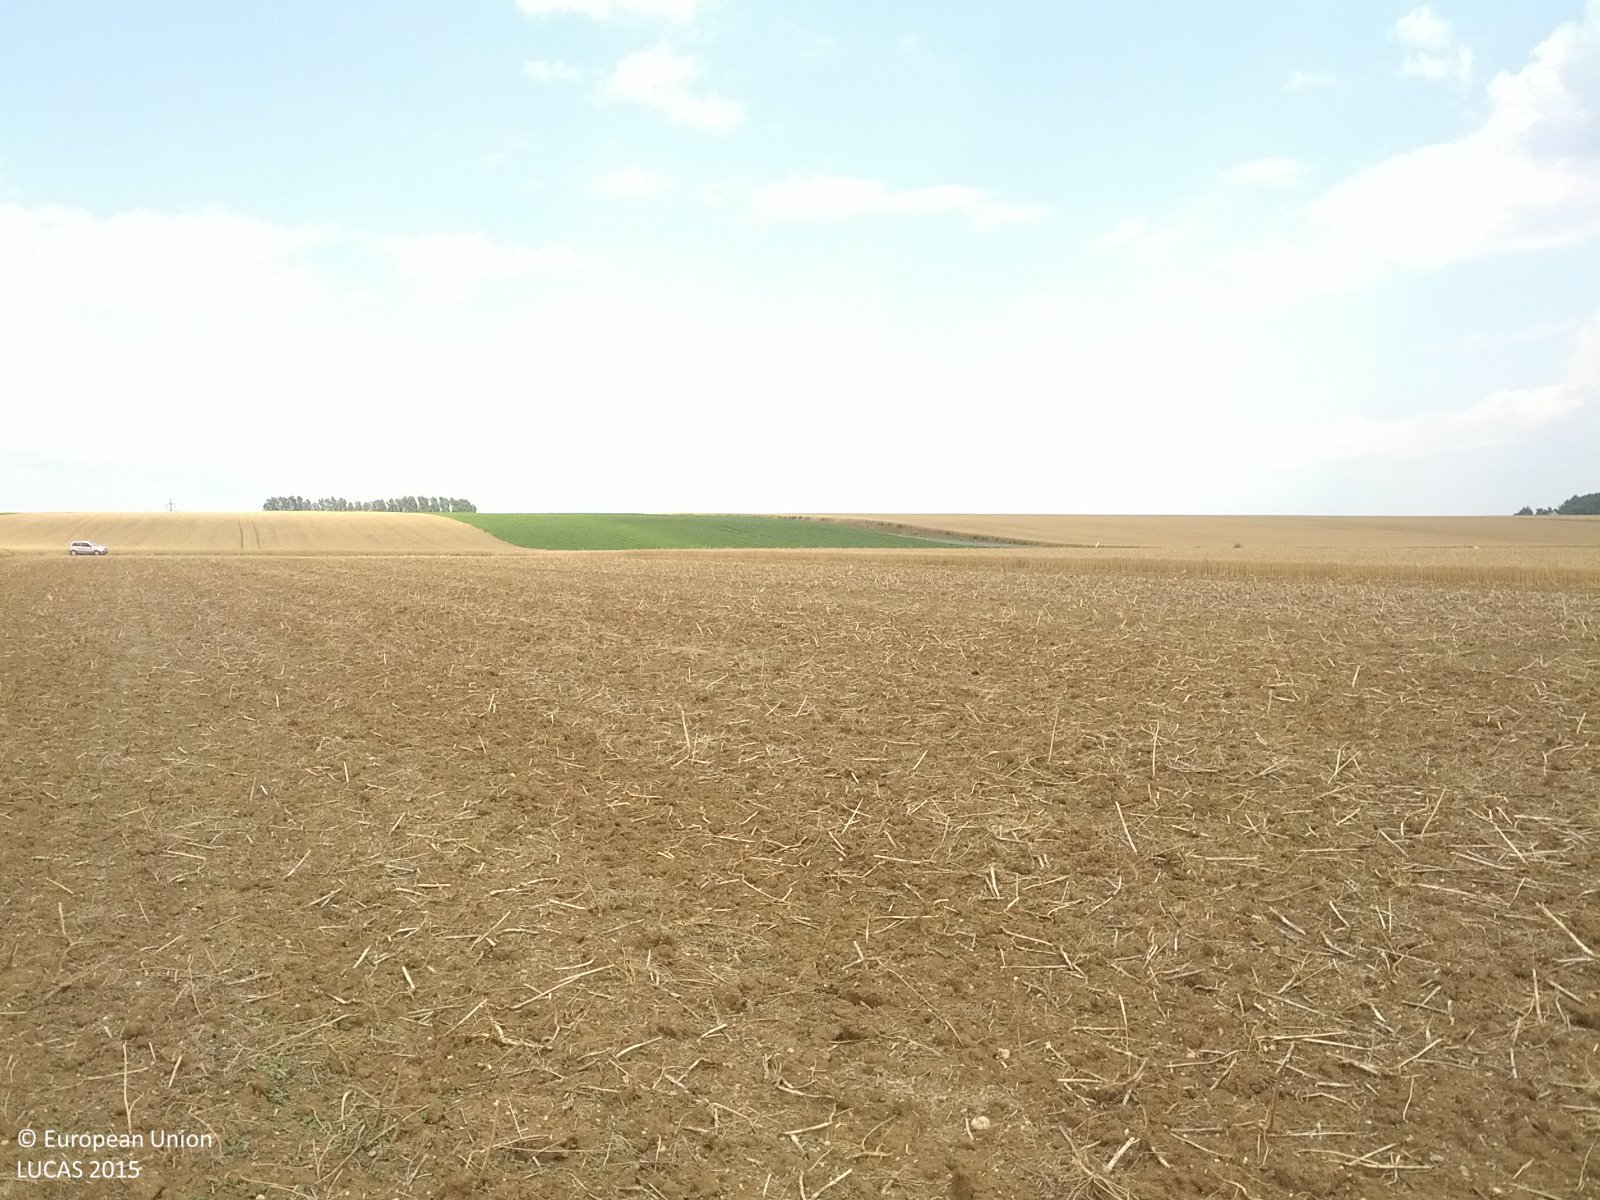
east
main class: Cropland
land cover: Rape and turnip rape
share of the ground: < 10 %
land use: Agriculture (excluding fallow land and kitchen gardens)
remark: Harvested field
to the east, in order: Rape and turnip rape; Common wheat; Grass margins; Tracks; Grass margins; Soya
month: July
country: AT
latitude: 47.2816
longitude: 16.3619
